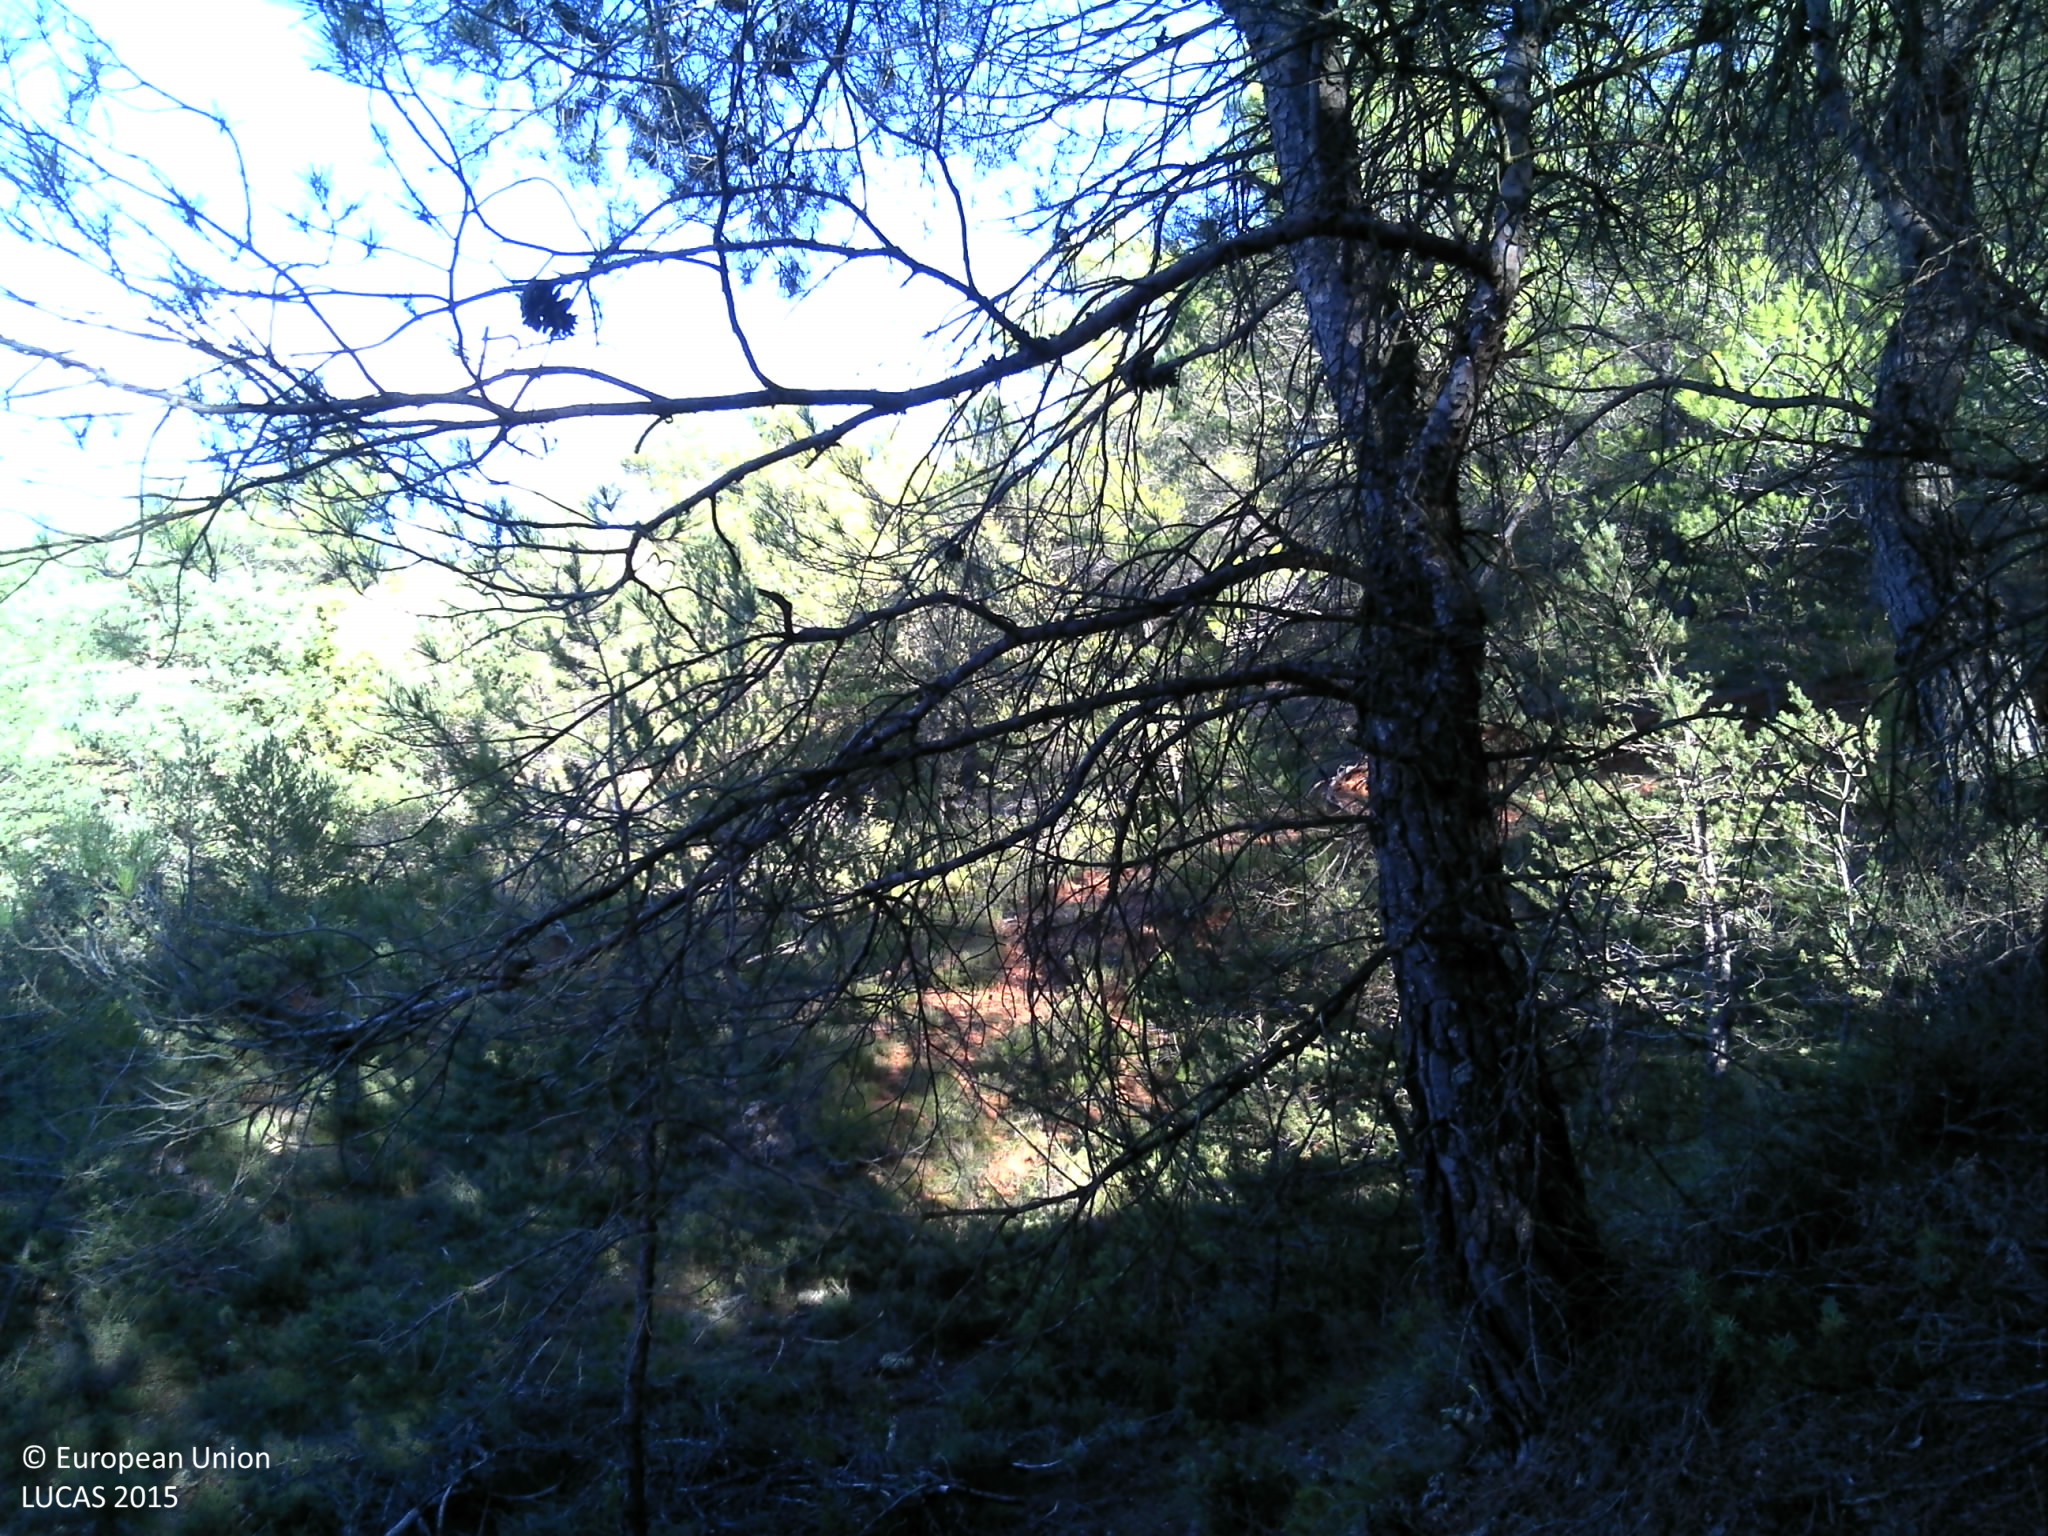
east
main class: Woodland
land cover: Pine dominated mixed woodland
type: coniferous forest of the mediterranean region
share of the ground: 50 - 75 %
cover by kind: coniferous forest trees 50 %, broadleaved forest trees 25 %, shrubs 20 %, herbaceous plants 5 %
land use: Forestry
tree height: > 5 m
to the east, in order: Pine dominated mixed woodland; Ditches and canals; Other fresh vegetables; Pine dominated mixed woodland; Tracks; Shrubland without tree cover; Pine dominated mixed woodland; Rock outcrops; Pine dominated mixed woodland; Ditches and canals; Other bare soil; Grassland without tree/shrub cover; Artificial constructions in urban areas
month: September
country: FR
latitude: 43.8801
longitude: 5.2420
